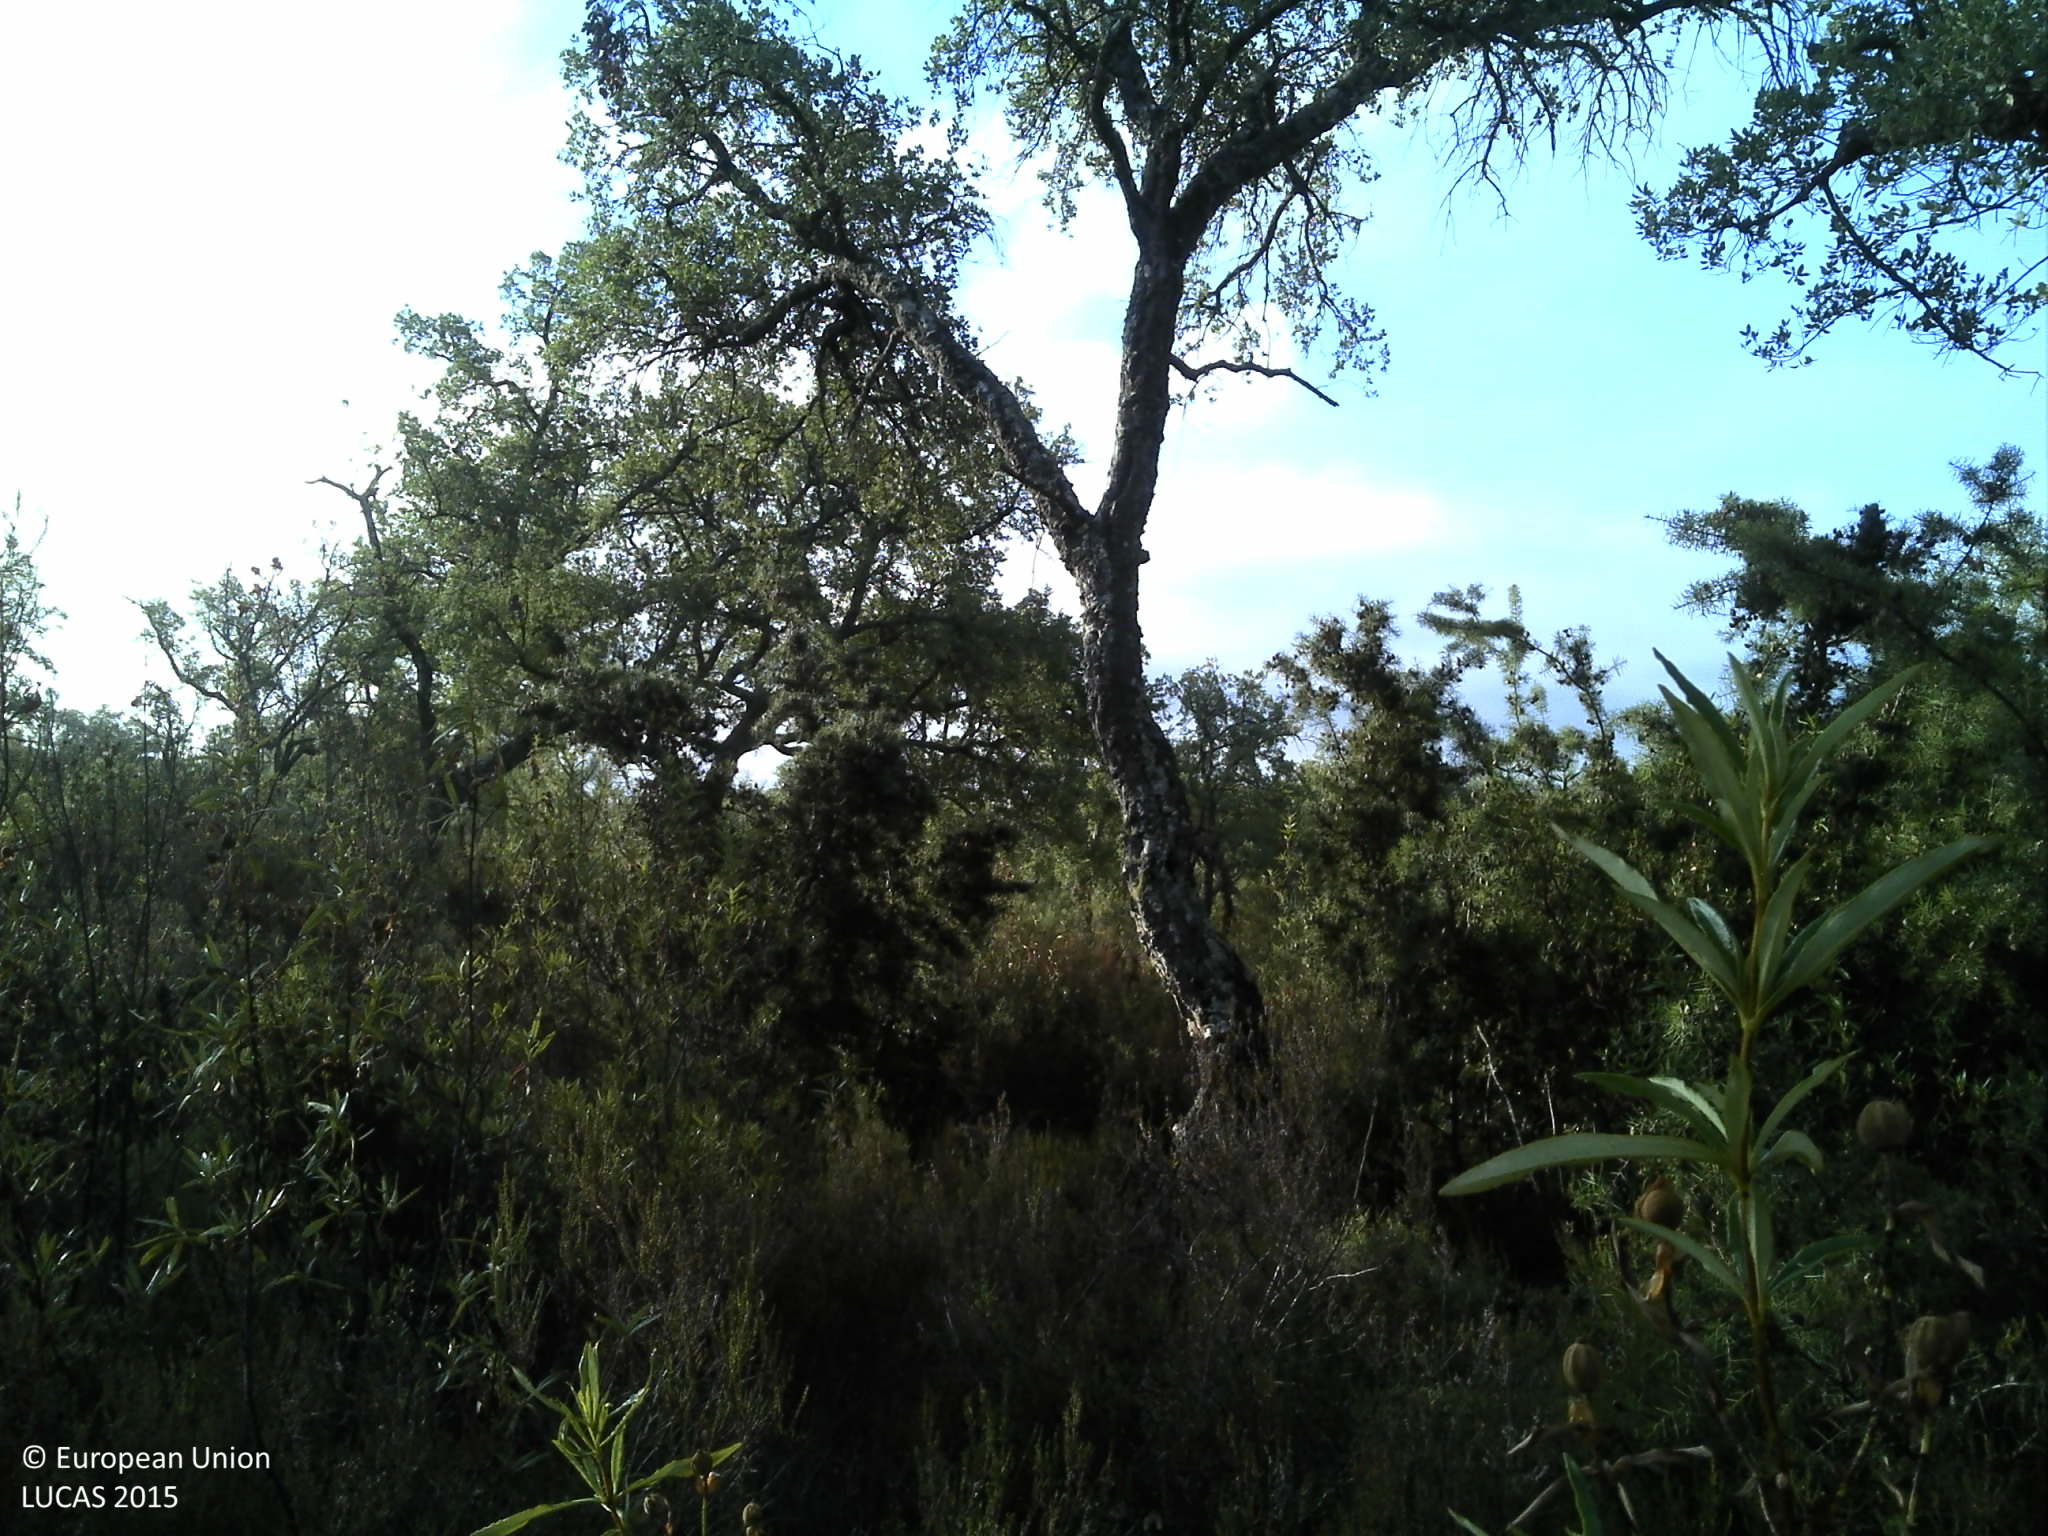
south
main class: Woodland
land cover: Broadleaved woodland
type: broadleaved evergreen forest
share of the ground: 10 - 25 %
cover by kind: shrubs 85 %, broadleaved forest trees 15 %
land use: Forestry
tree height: > 5 m
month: July
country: PT
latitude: 39.4175
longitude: -7.9080
